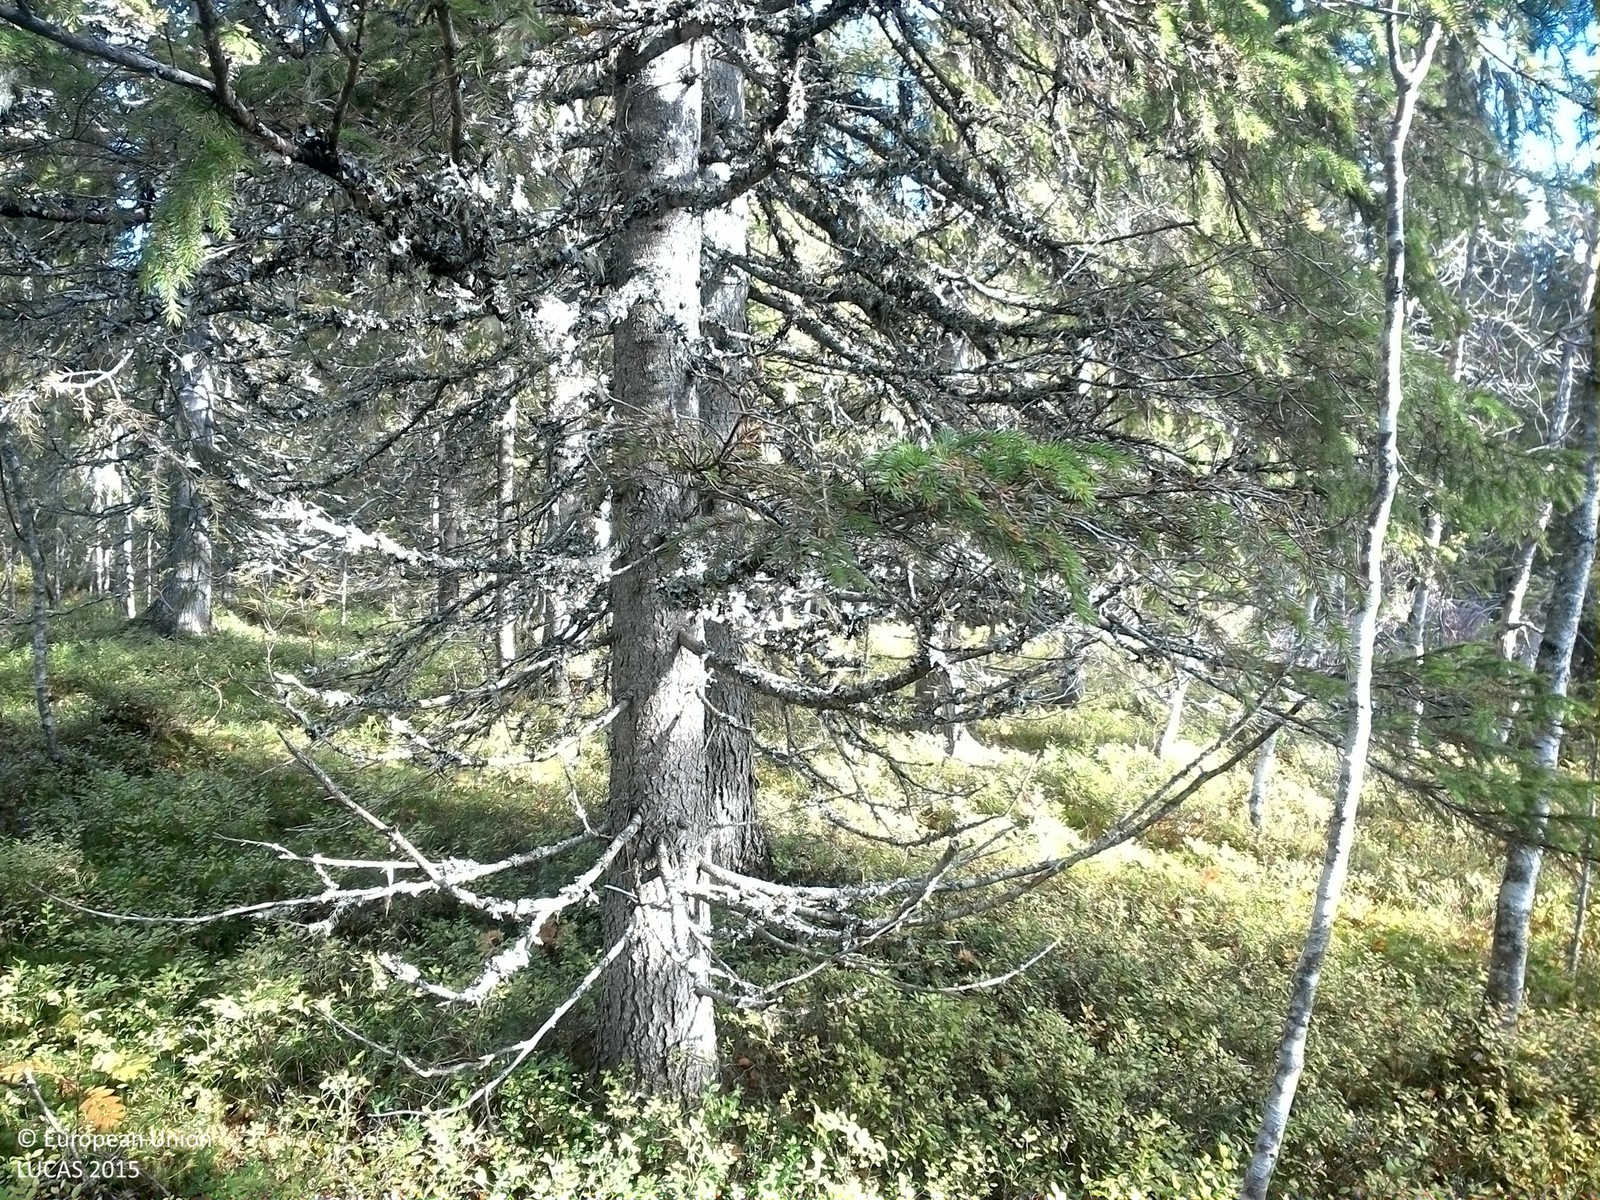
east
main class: Woodland
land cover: Spruce dominated coniferous woodland
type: boreal forest
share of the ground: 50 - 75 %
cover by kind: coniferous forest trees 50 %, shrubs 20 %, broadleaved forest trees 15 %, lichens and mosses 15 %
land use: Forestry
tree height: > 5 m
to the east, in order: Spruce dominated coniferous woodland; Rivers and streams; Spruce dominated coniferous woodland; Spruce dominated mixed woodland; Rivers and streams; Spruce dominated mixed woodland
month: October
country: SE
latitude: 64.2120
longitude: 16.0068
